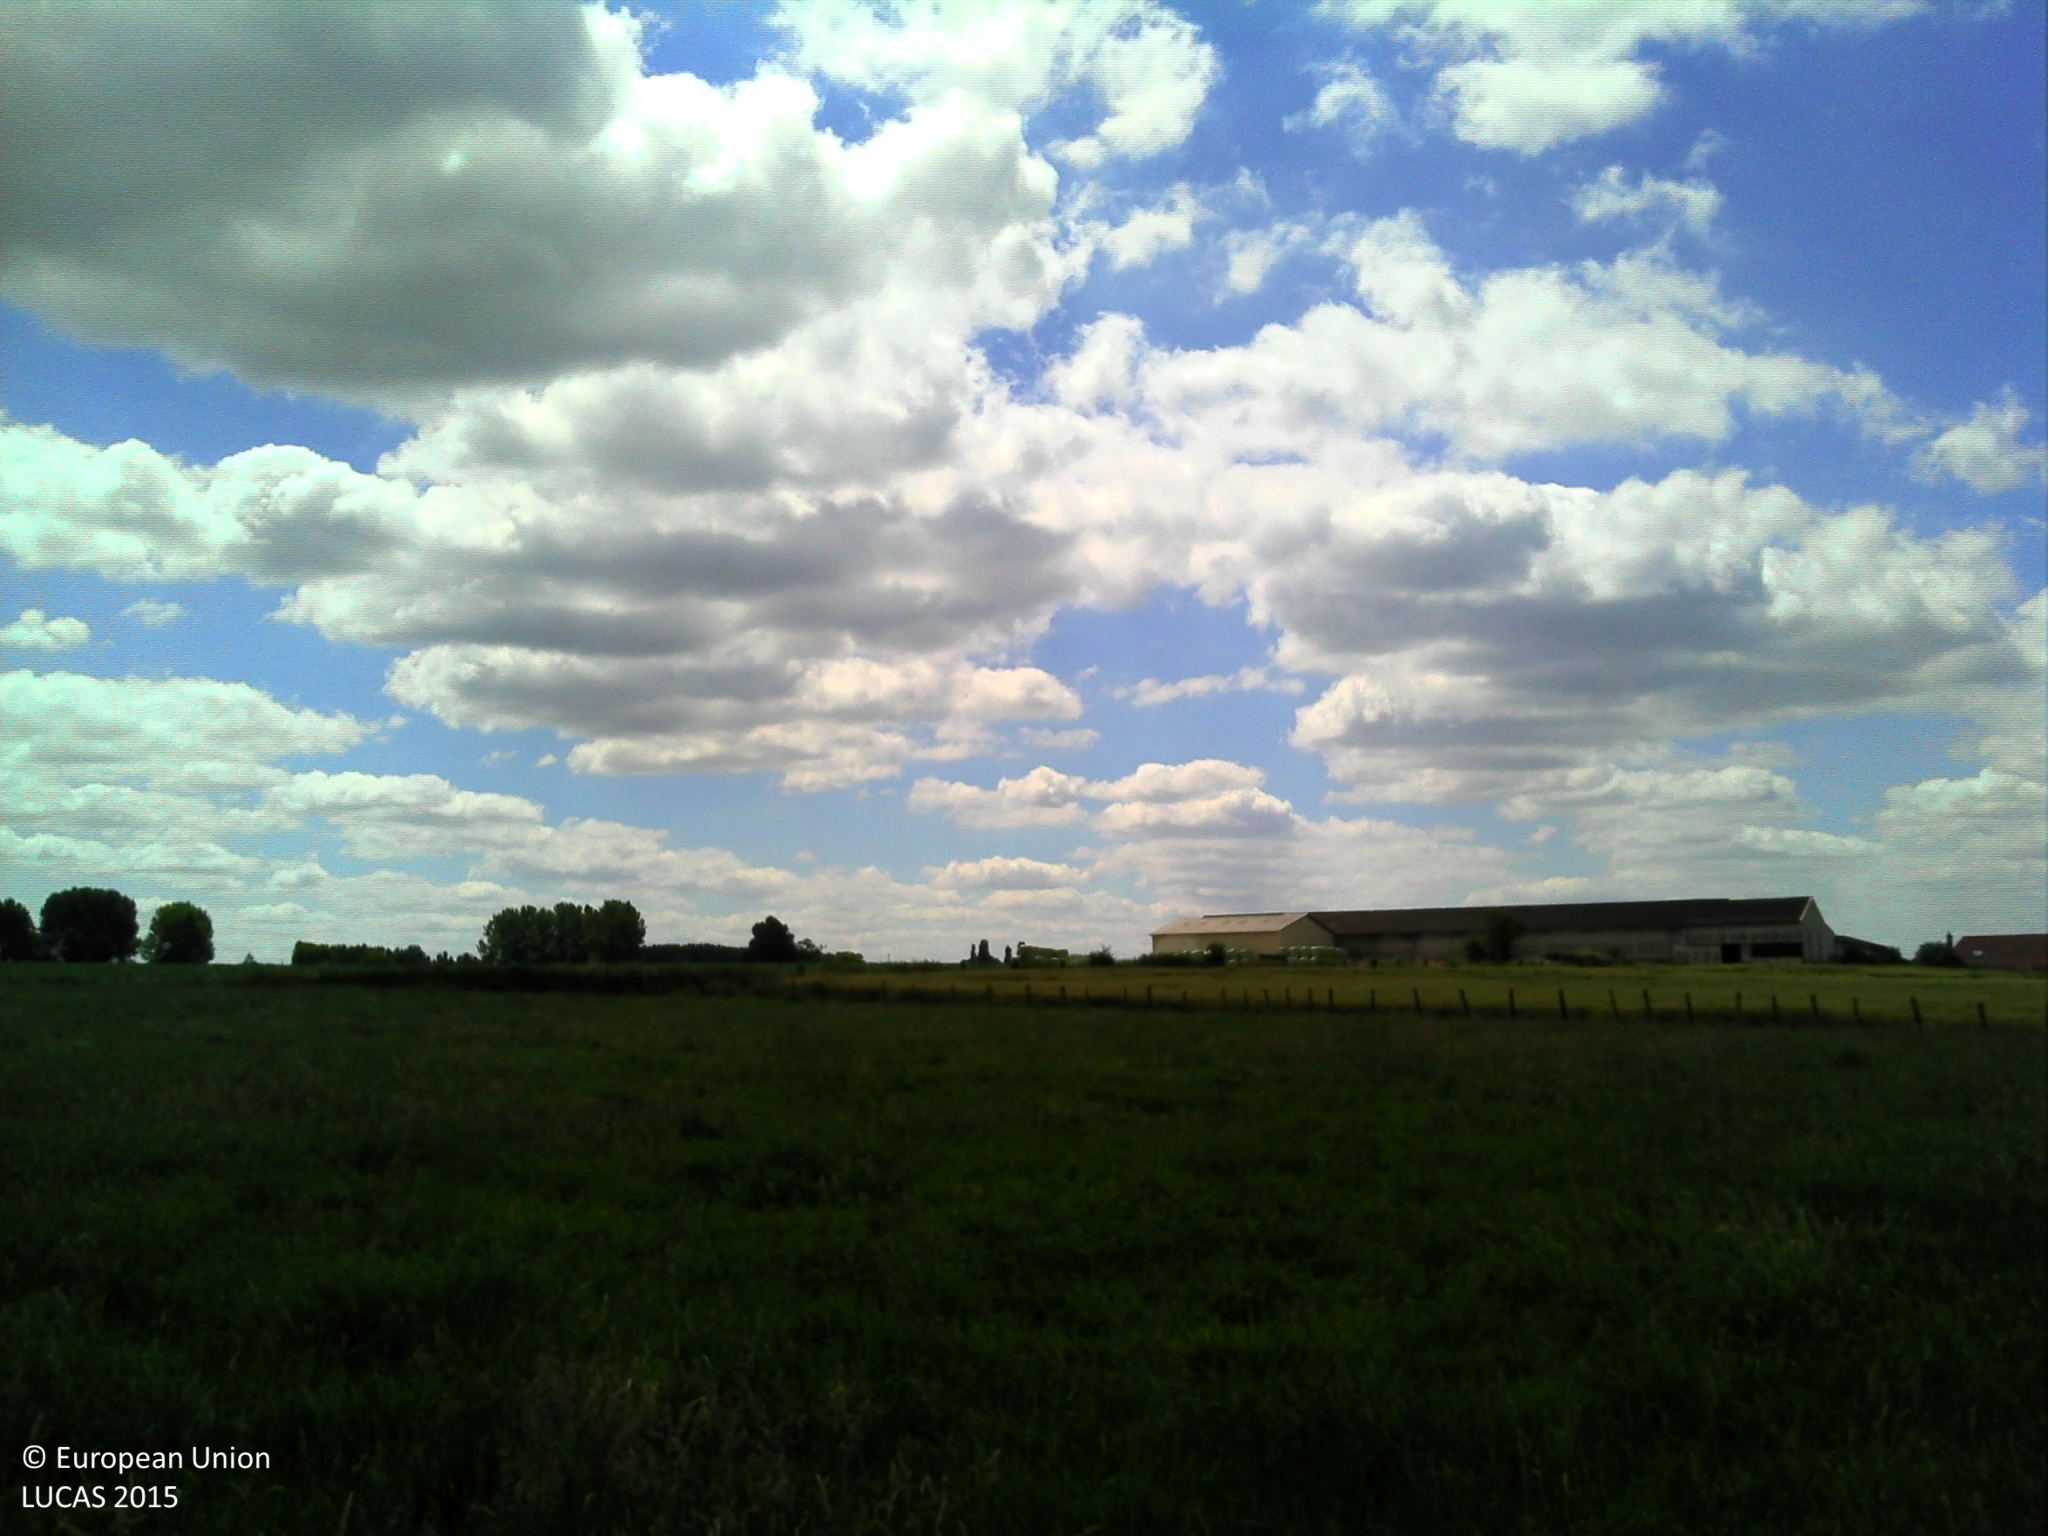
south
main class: Grassland
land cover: Grassland without tree/shrub cover
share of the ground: > 75 %
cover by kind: herbaceous plants 100 %
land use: Agriculture (excluding fallow land and kitchen gardens)
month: June
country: FR
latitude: 47.8433
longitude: 0.2338
